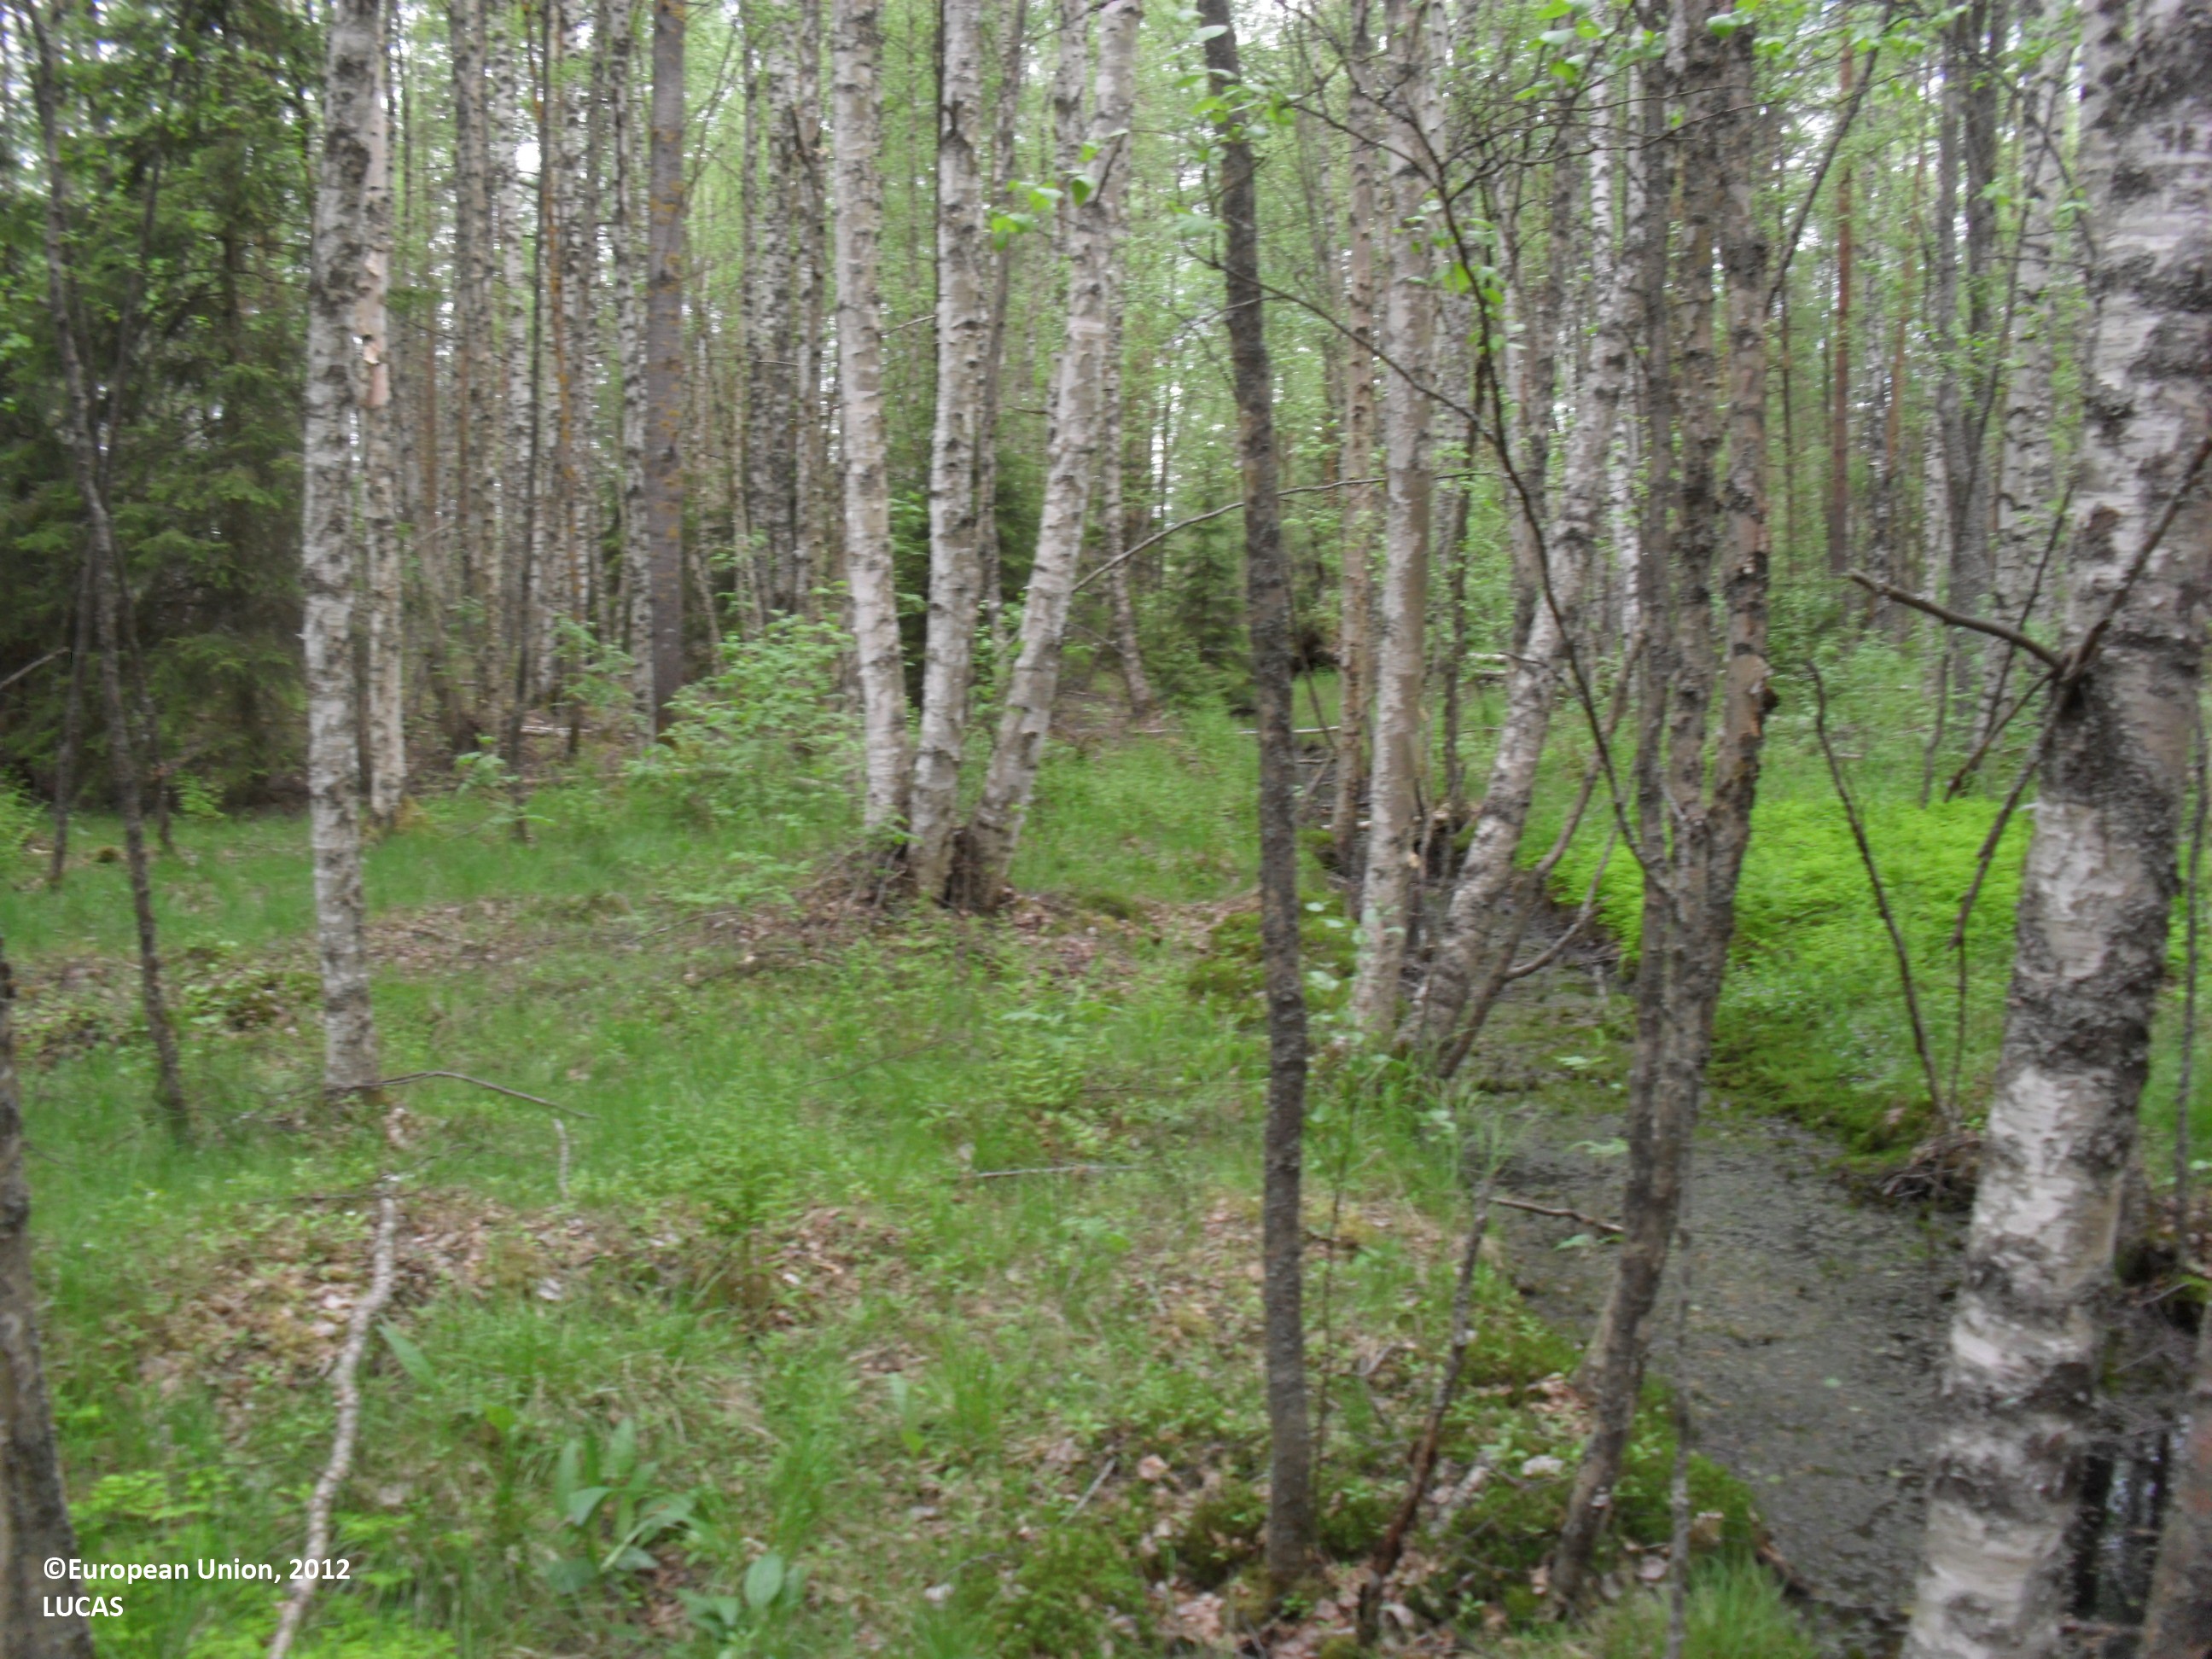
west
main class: Woodland
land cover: Other mixed woodland
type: boreal forest
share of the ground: 50 - 75 %
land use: Forestry
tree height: > 5 m
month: June
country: FI
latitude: 62.9112
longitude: 22.9517
